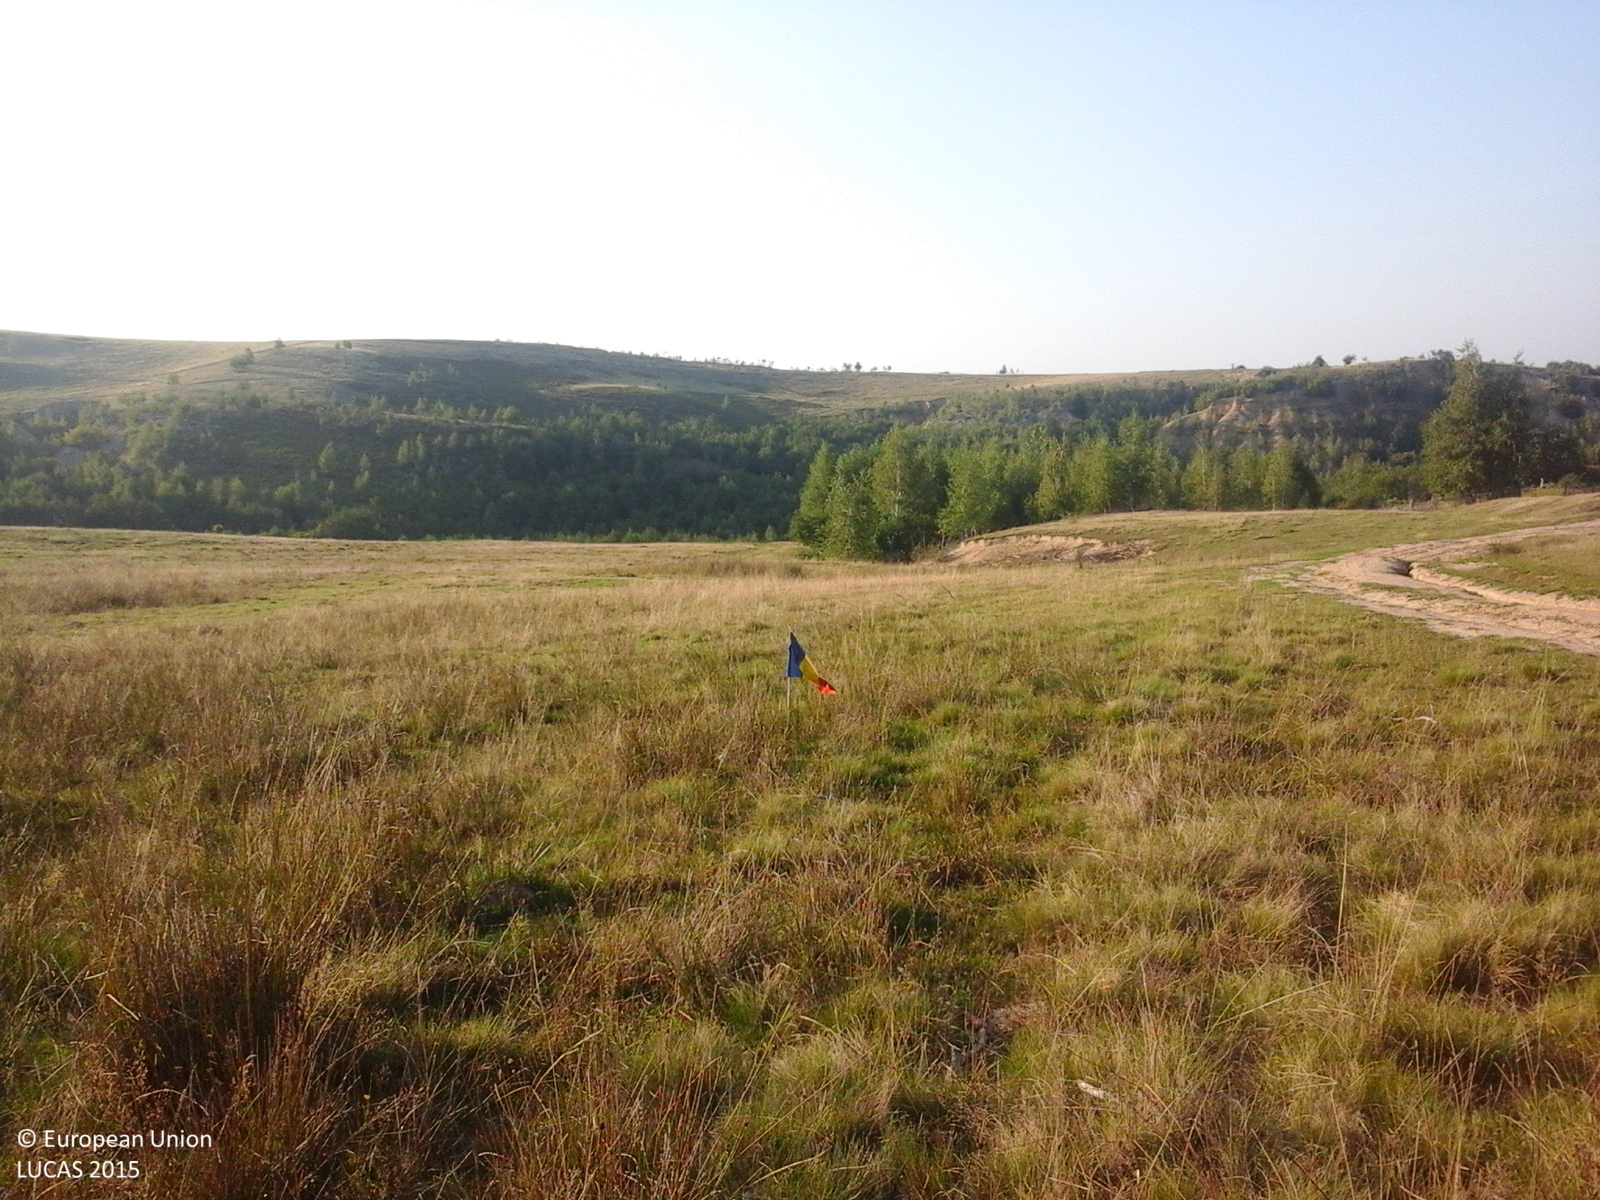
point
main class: Grassland
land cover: Grassland without tree/shrub cover
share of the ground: > 75 %
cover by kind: herbaceous plants 100 %
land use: Agriculture (excluding fallow land and kitchen gardens)
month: September
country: RO
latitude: 47.1098
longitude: 22.6422
